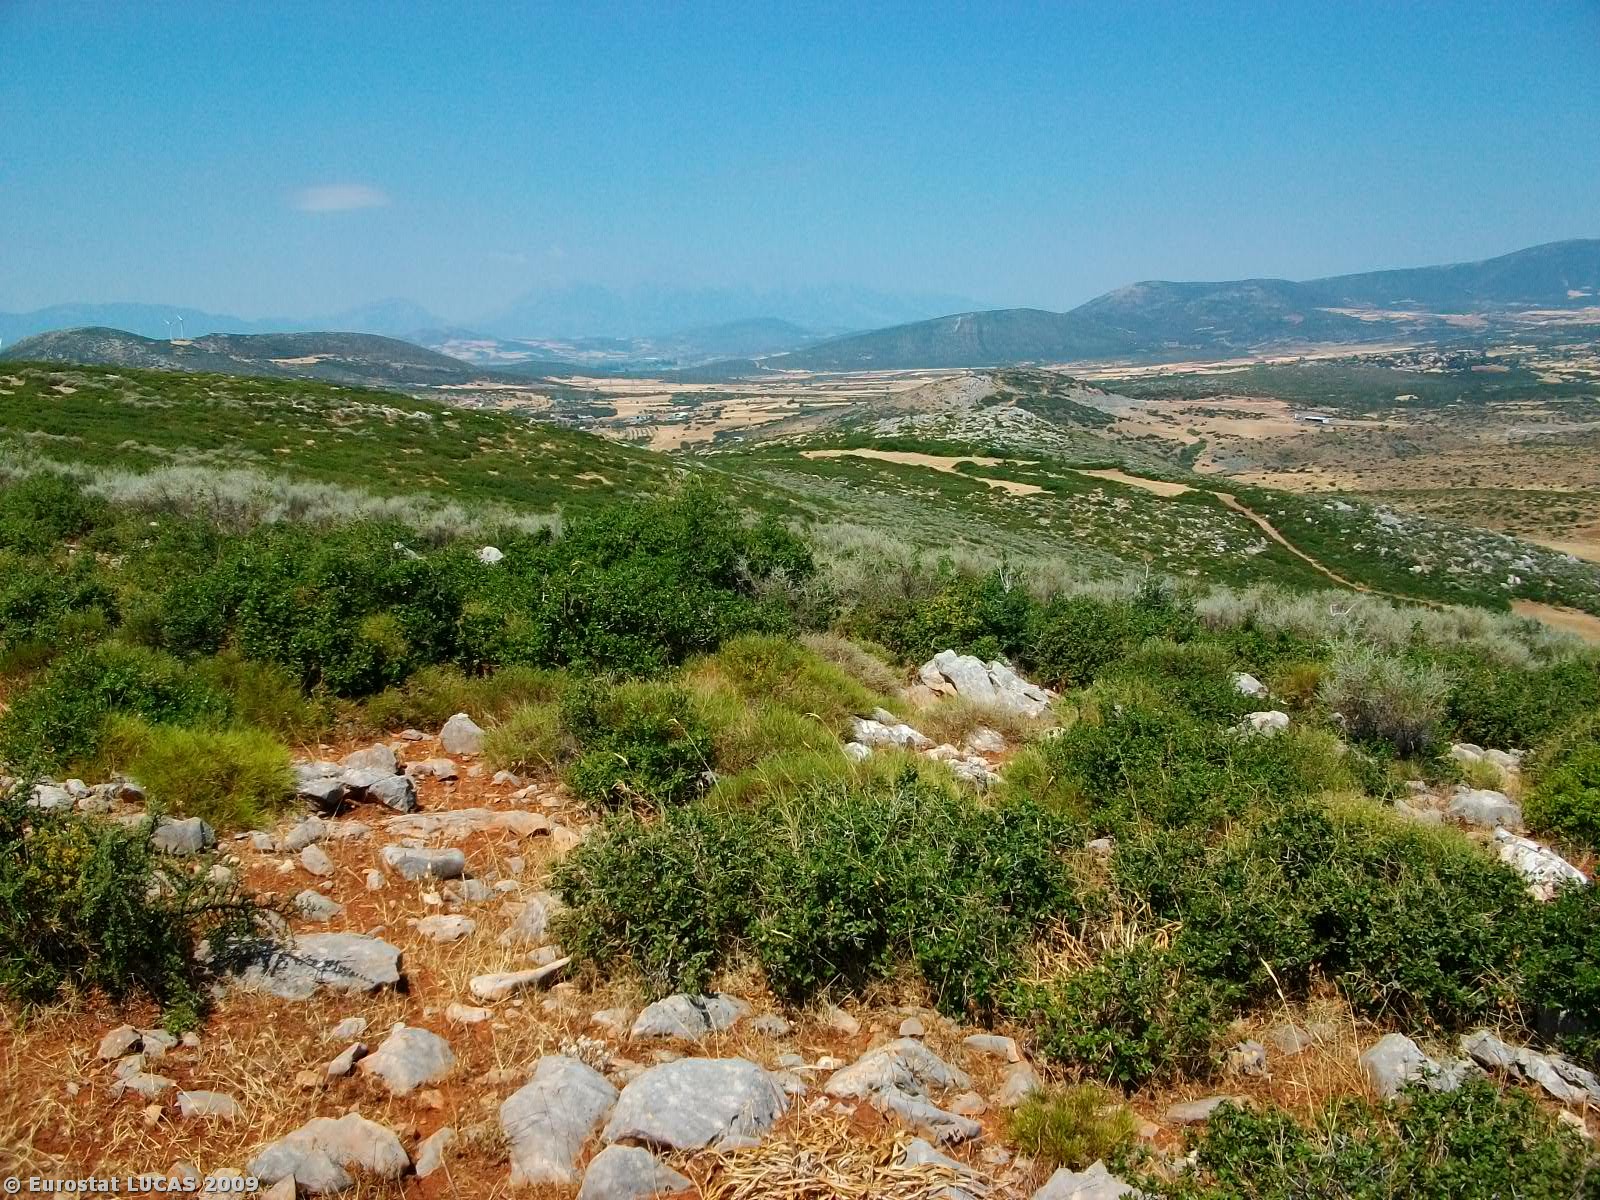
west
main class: Shrubland
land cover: Shrubland without tree cover
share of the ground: > 75 %
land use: Agriculture (excluding fallow land and kitchen gardens)
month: July
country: GR
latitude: 38.5398
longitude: 23.1184
